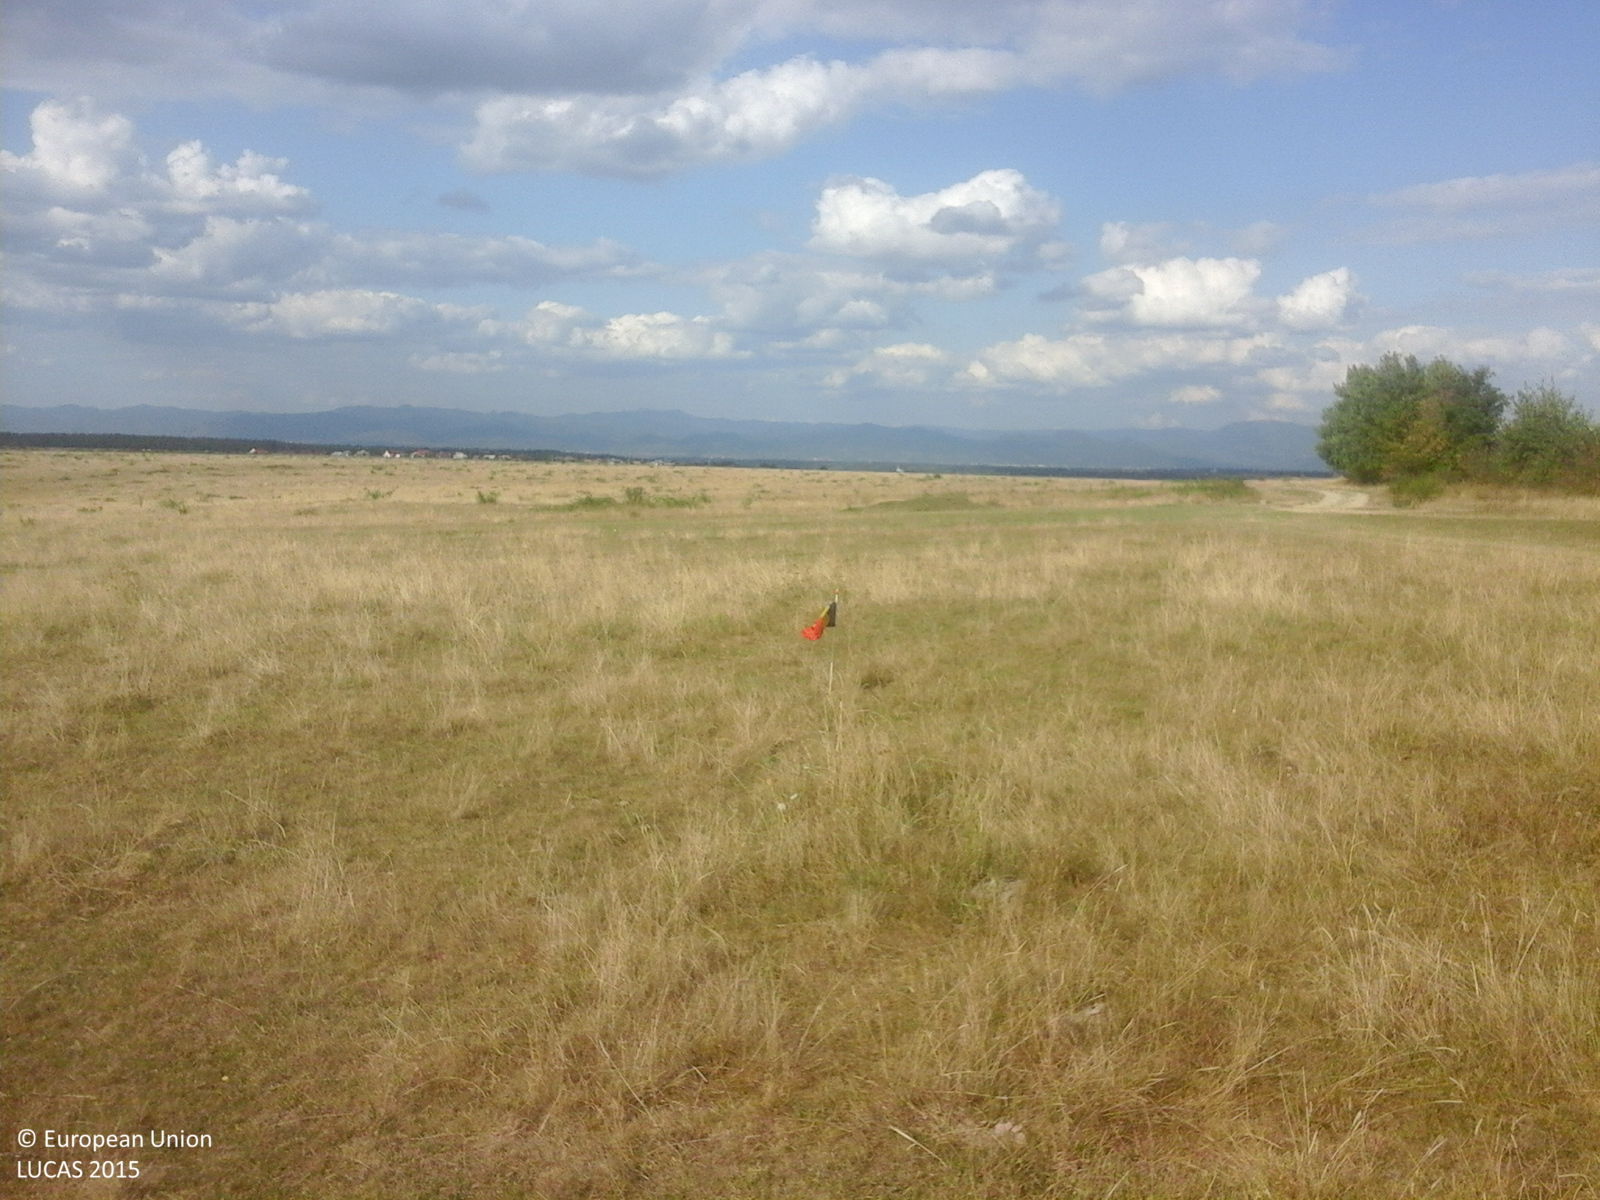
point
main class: Grassland
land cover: Grassland without tree/shrub cover
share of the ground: > 75 %
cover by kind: herbaceous plants 100 %
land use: Agriculture (excluding fallow land and kitchen gardens)
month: September
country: RO
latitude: 47.4874
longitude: 23.4376
